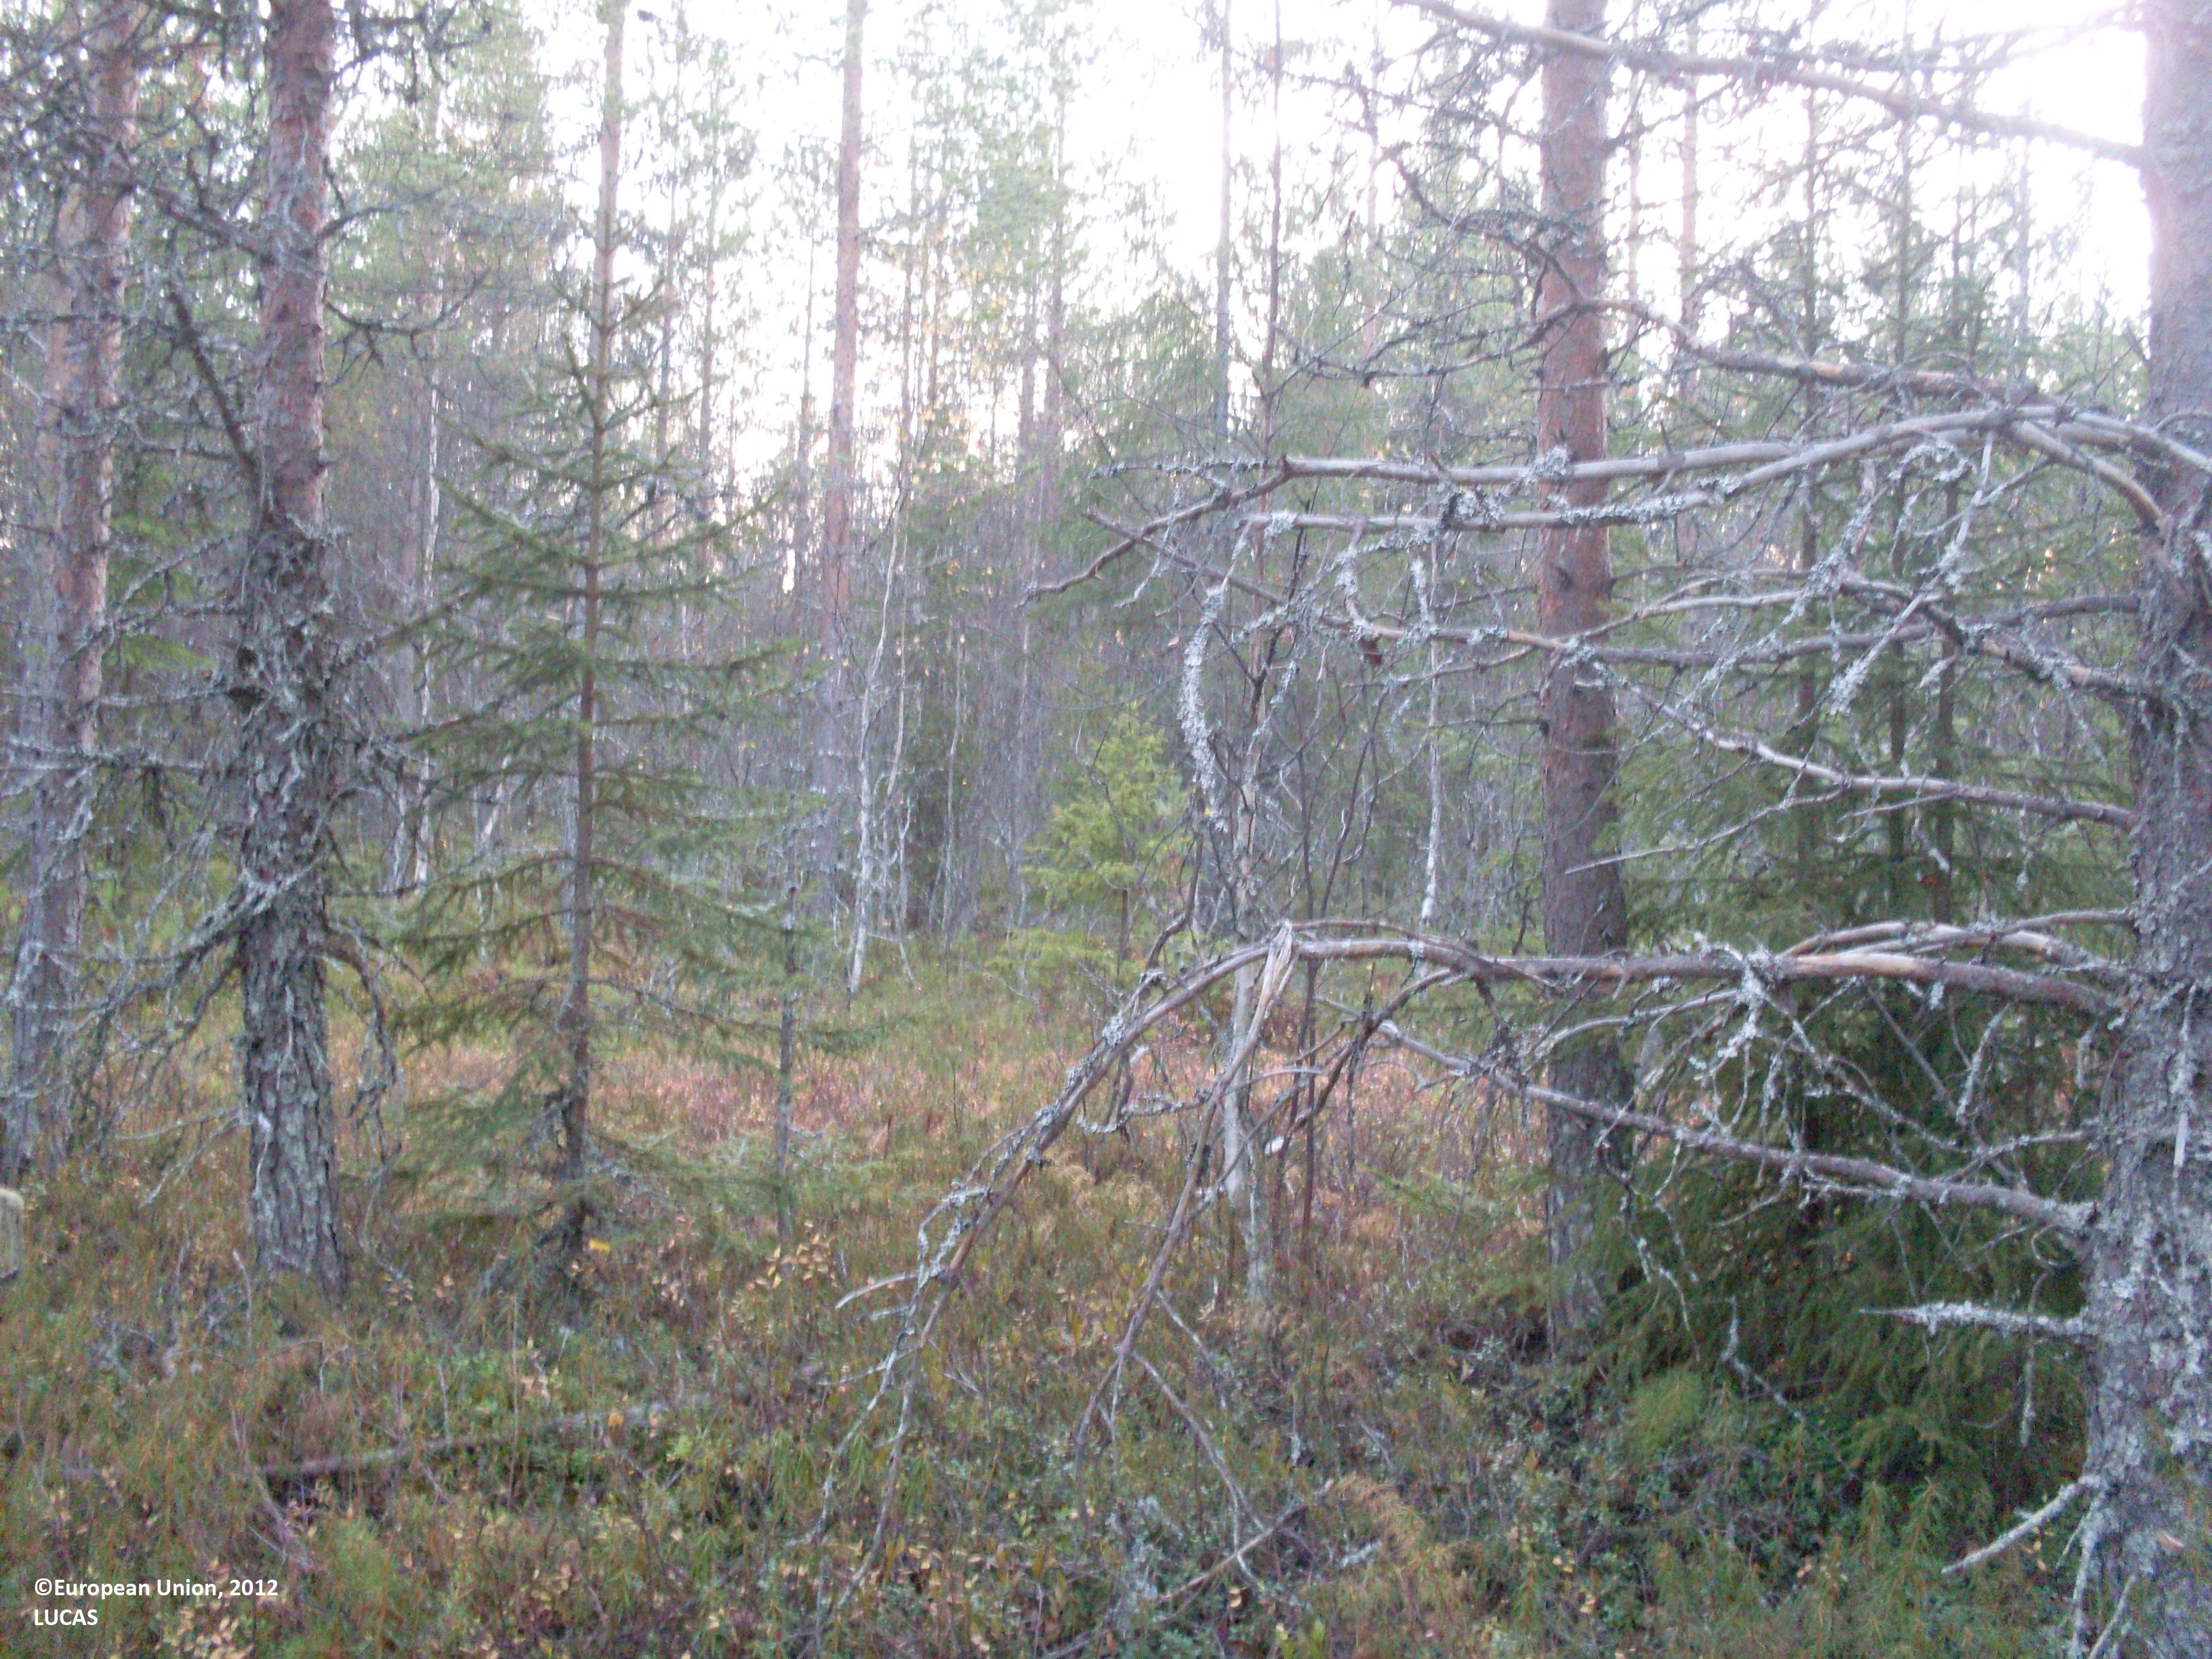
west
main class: Woodland
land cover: Pine dominated mixed woodland
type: boreal forest
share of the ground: 50 - 75 %
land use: Forestry
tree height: > 5 m
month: September
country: FI
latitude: 64.6180
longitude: 29.5979
